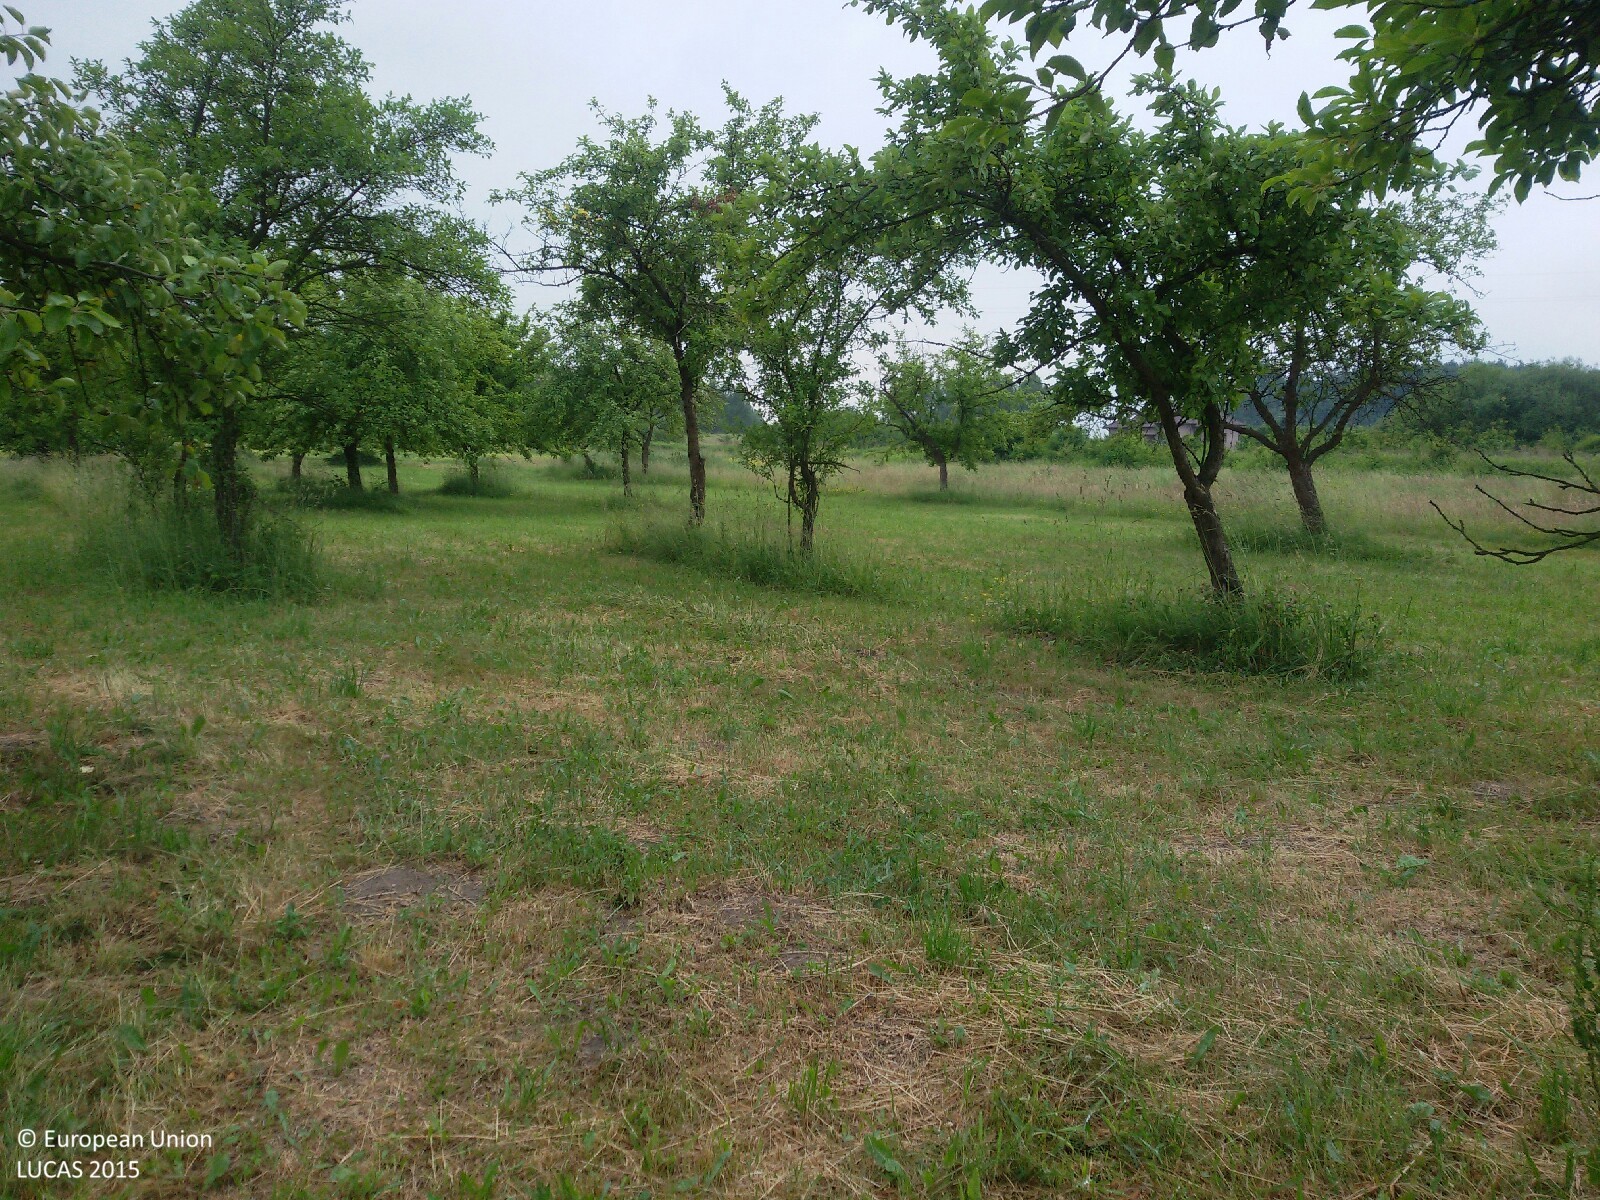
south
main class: Cropland
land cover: Apple fruit
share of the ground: > 75 %
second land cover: Grassland without tree/shrub cover
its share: > 75 %
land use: Agriculture (excluding fallow land and kitchen gardens)
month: June
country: PL
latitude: 52.0002
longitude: 21.1012
